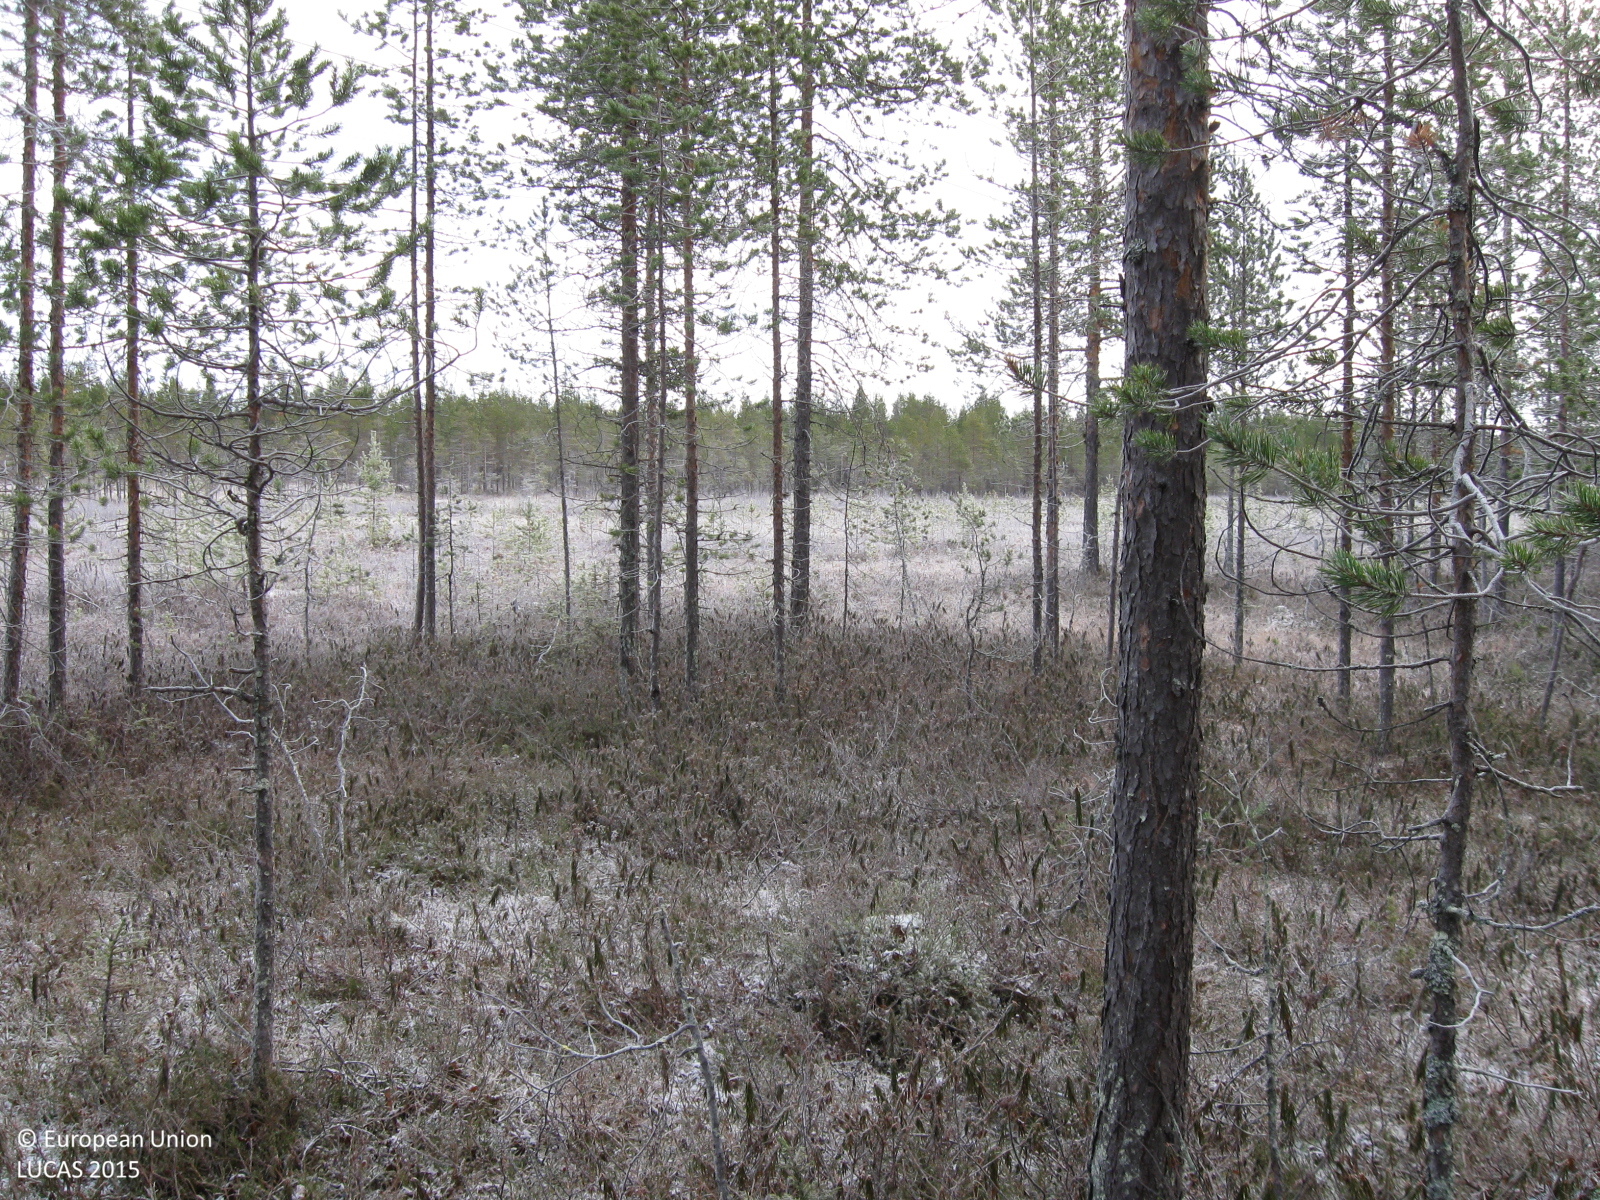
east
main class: Woodland
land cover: Pine dominated coniferous woodland
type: mire and swamp forests
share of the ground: 50 - 75 %
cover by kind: coniferous forest trees 55 %, shrubs 25 %, herbaceous plants 10 %, lichens and mosses 10 %
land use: Forestry
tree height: > 5 m
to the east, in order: Pine dominated coniferous woodland; Electric lines; Pine dominated coniferous woodland; Electric lines; Pine dominated coniferous woodland; Pine dominated mixed woodland; Pine dominated coniferous woodland
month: October
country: SE
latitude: 66.1146
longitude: 21.3198
